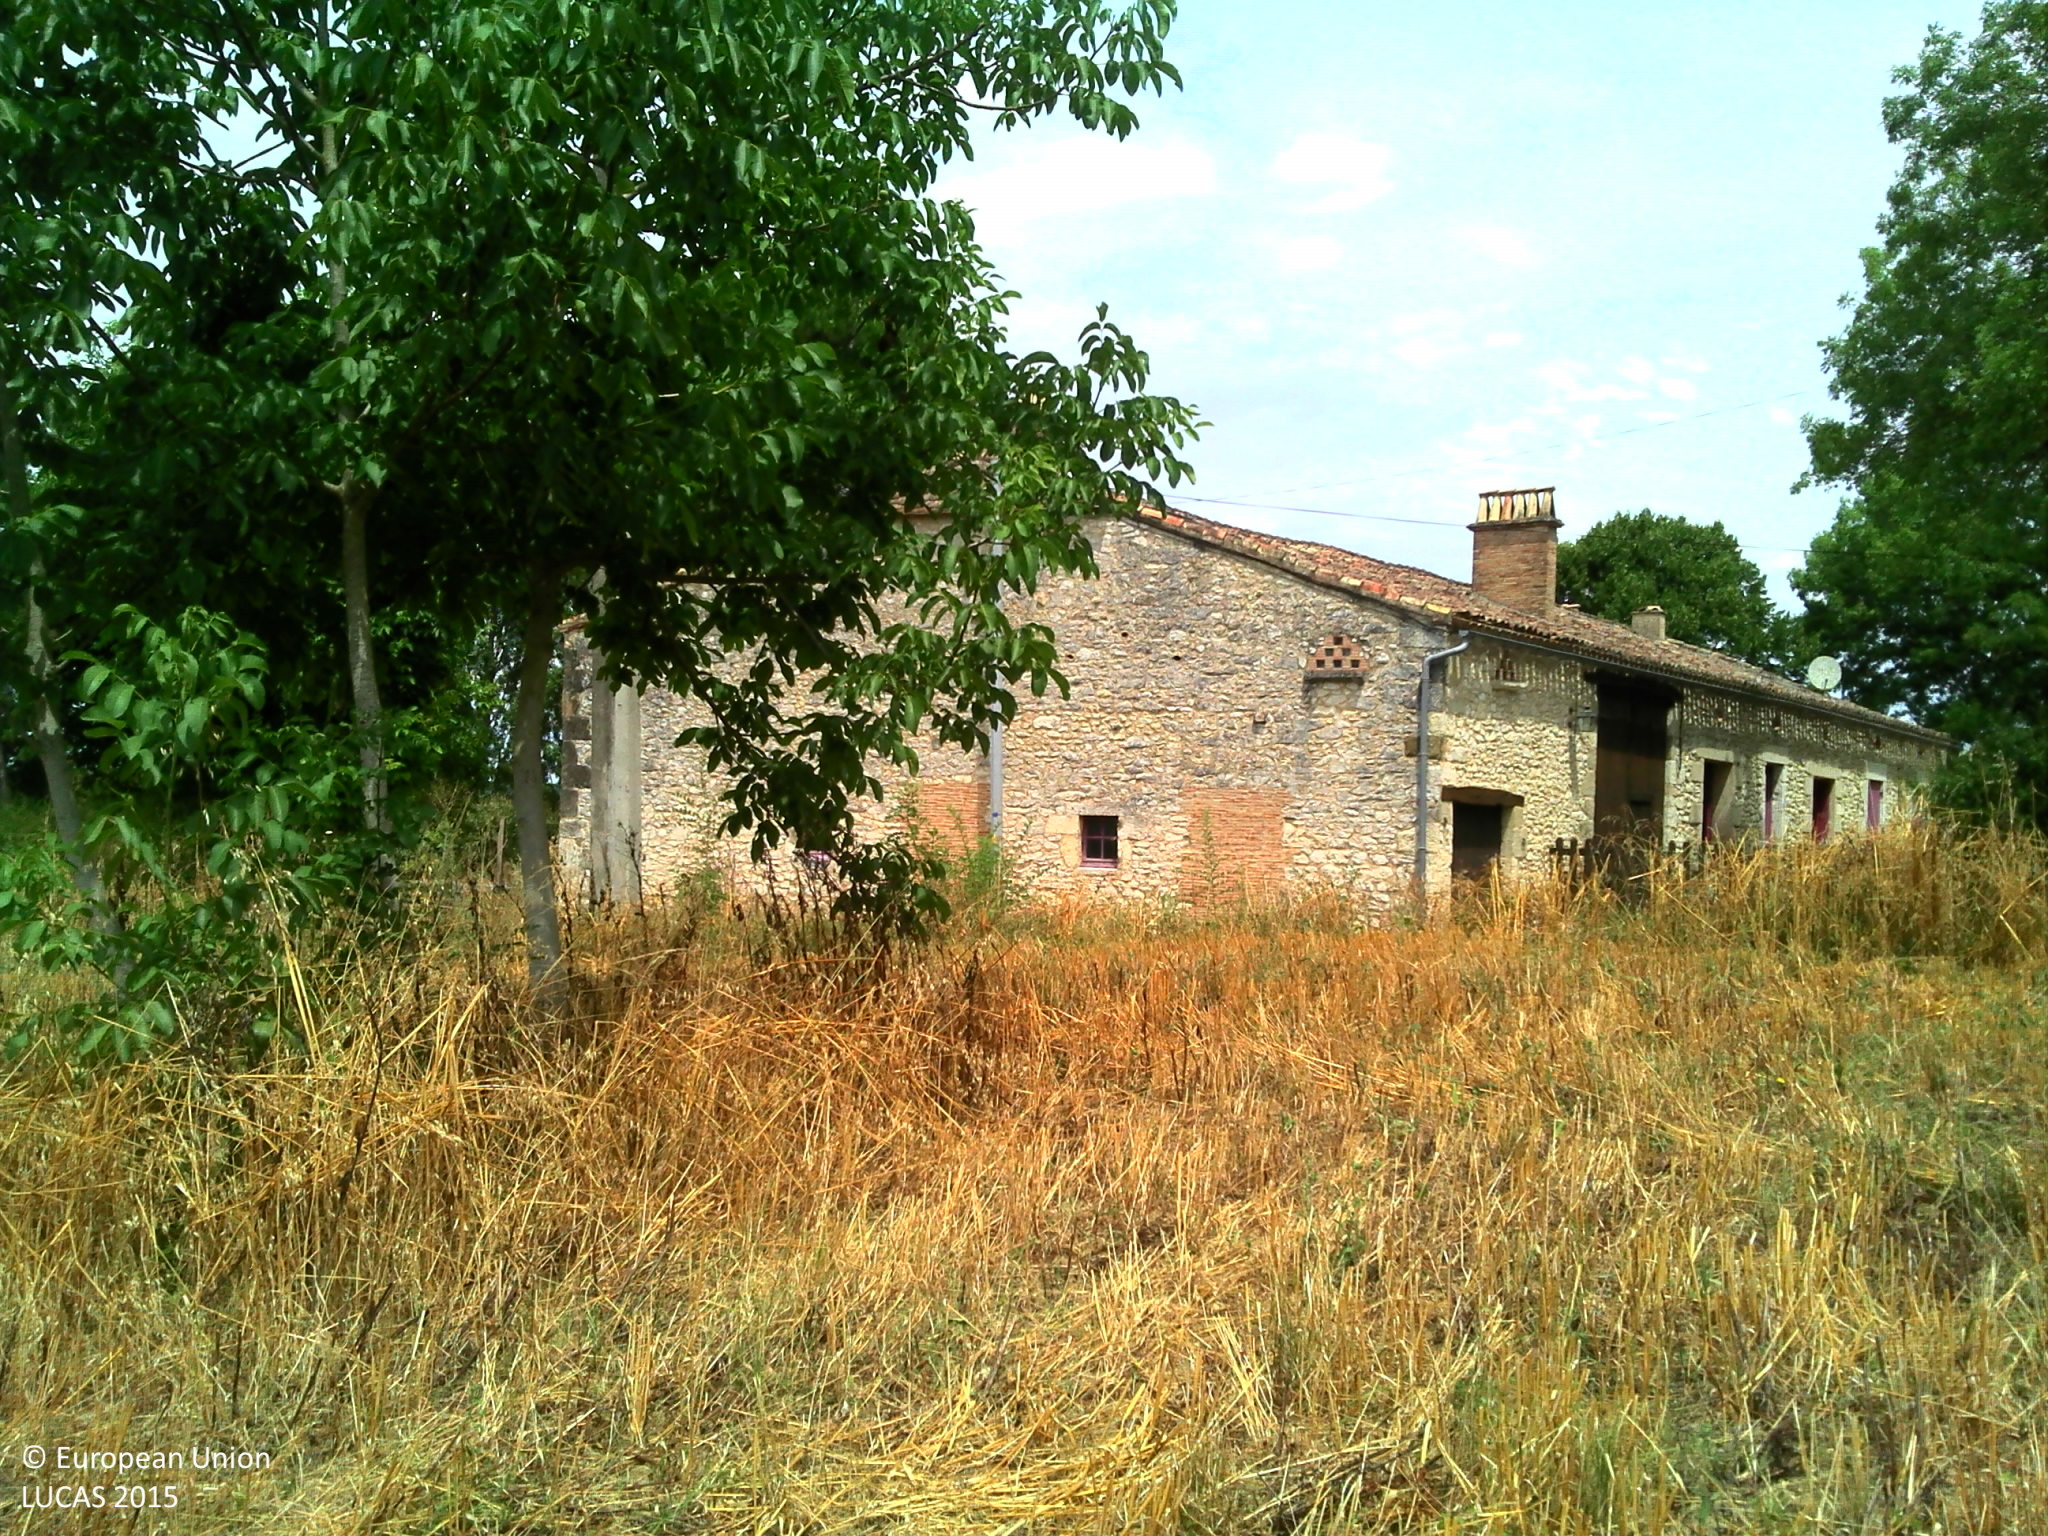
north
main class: Grassland
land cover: Grassland with sparse tree/shrub cover
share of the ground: > 75 %
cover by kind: herbaceous plants 95 %, broadleaved forest trees 5 %
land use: Agriculture (excluding fallow land and kitchen gardens)
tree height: < 5 m
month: July
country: FR
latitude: 44.6597
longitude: 0.5203
